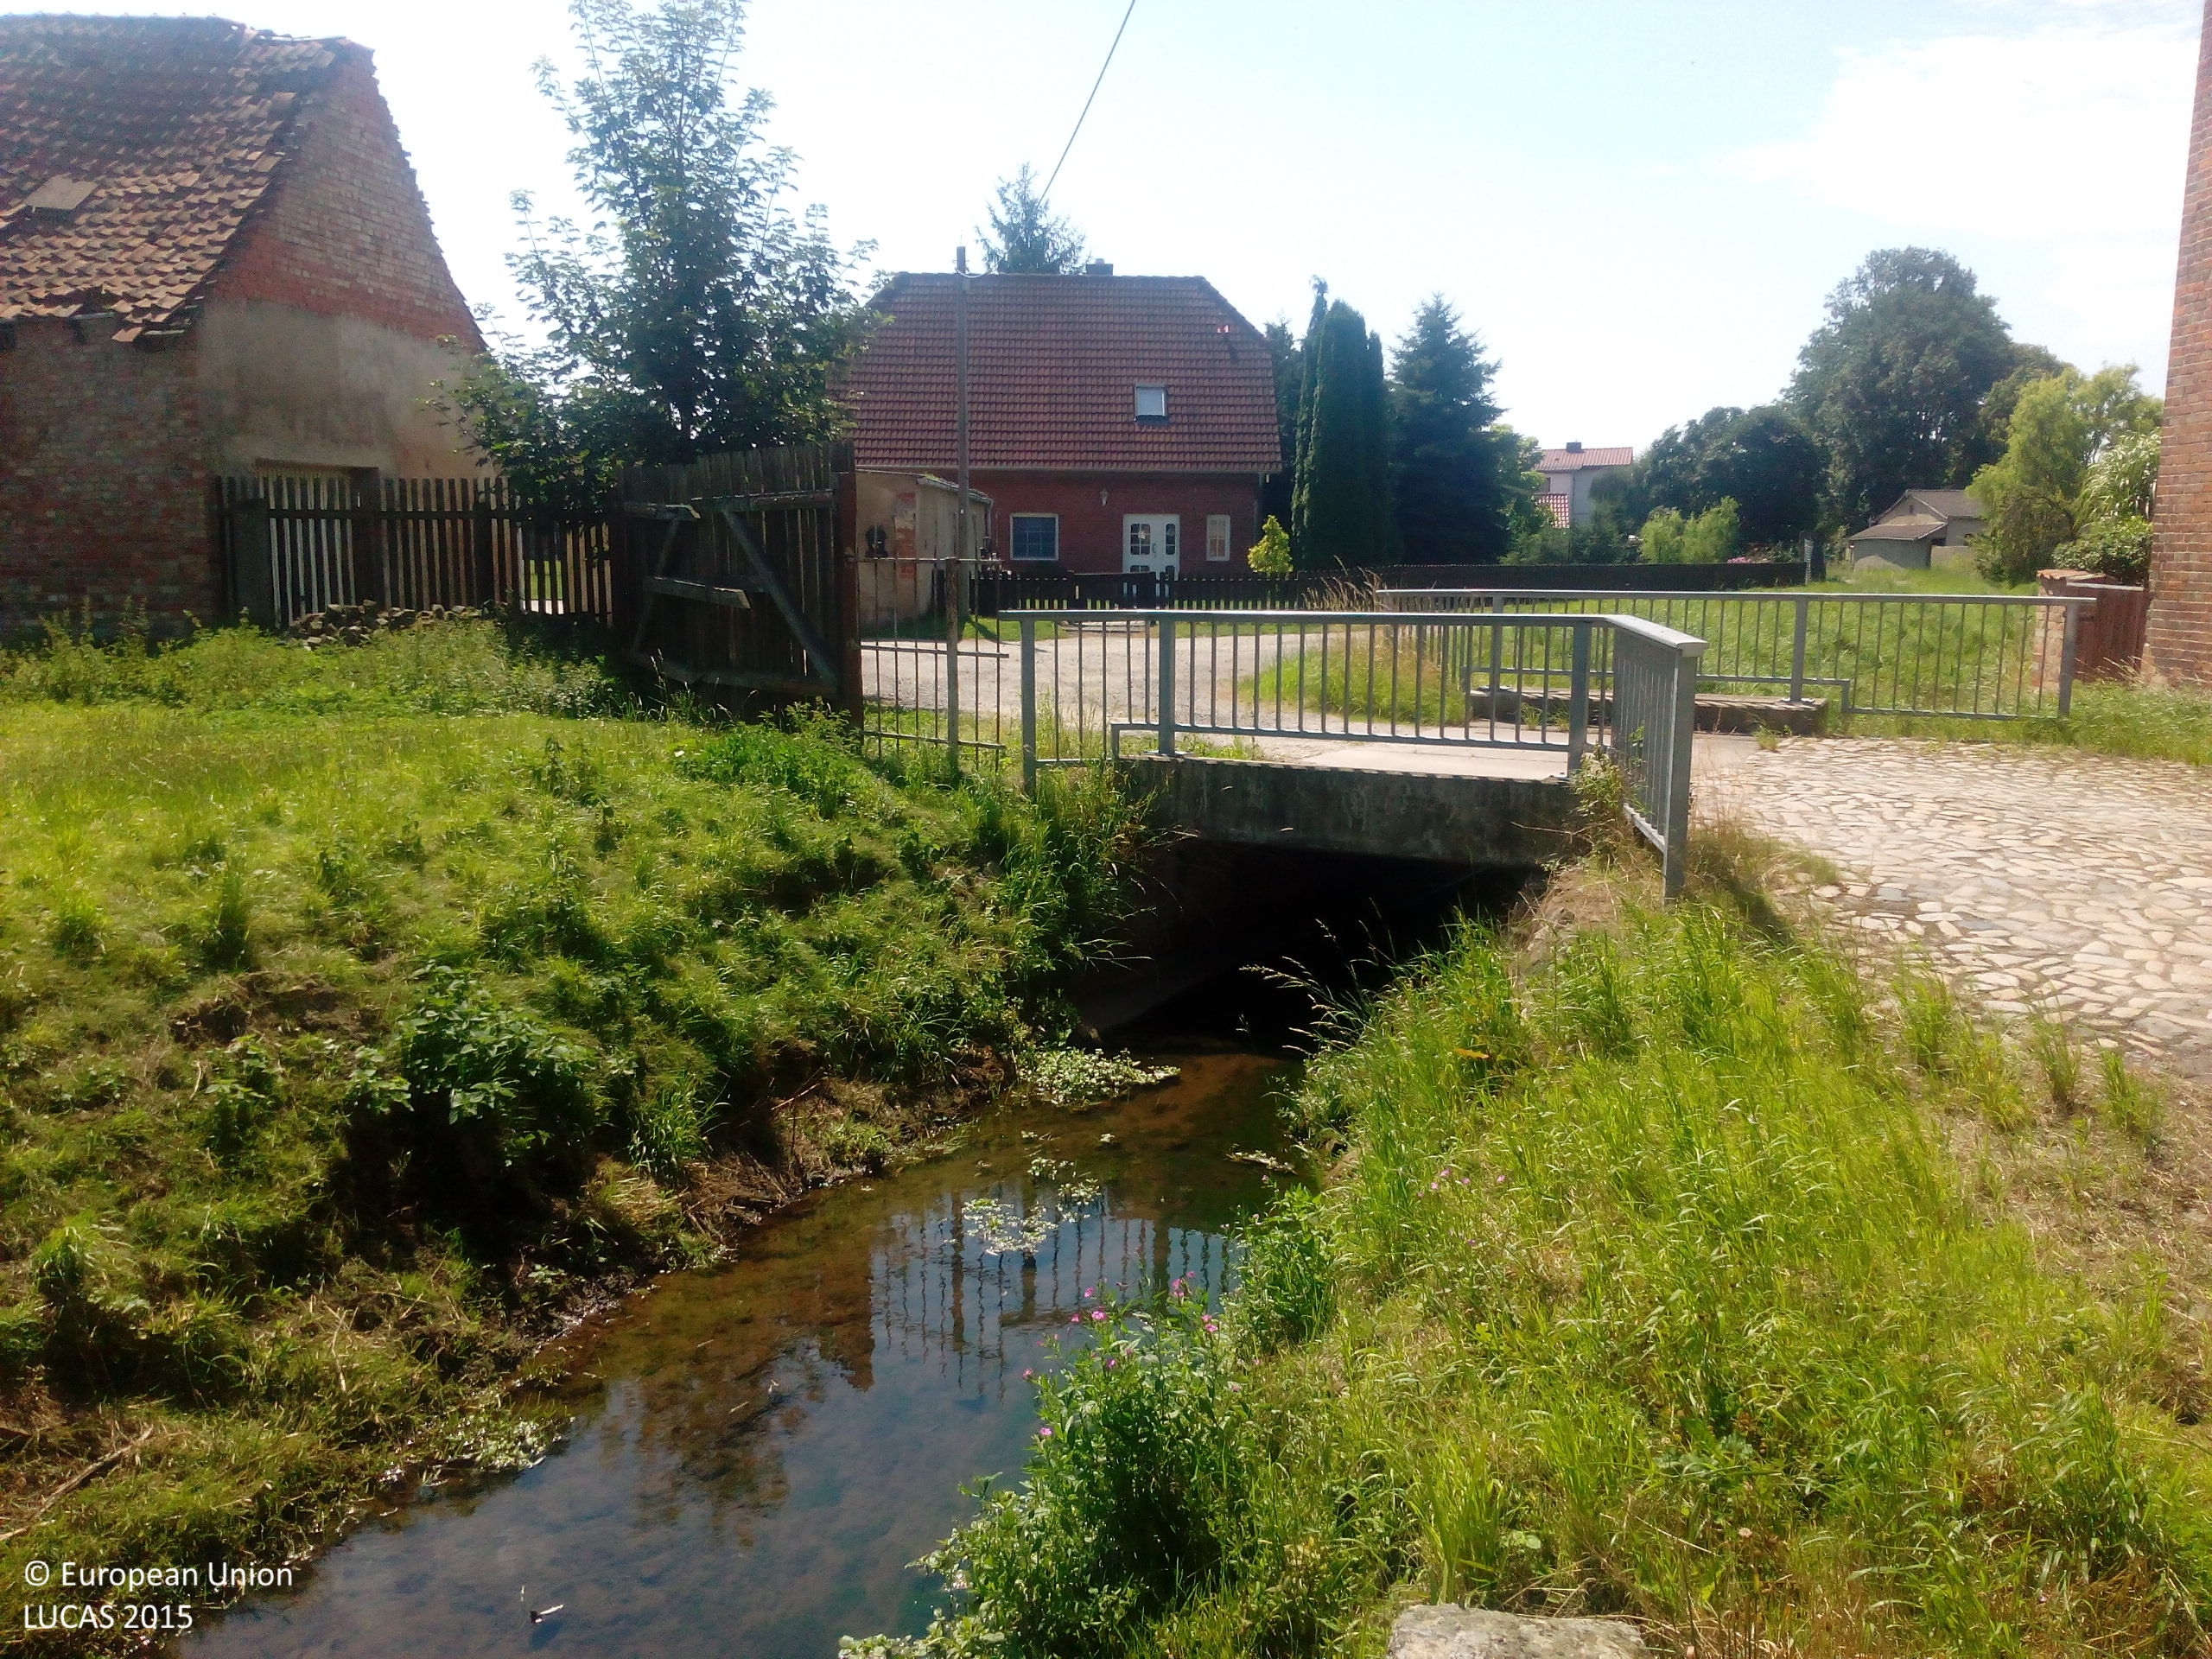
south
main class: Grassland
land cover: Grassland with sparse tree/shrub cover
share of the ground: > 75 %
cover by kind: herbaceous plants 95 %, broadleaved forest trees 5 %
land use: Residential
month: August
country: DE
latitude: 52.0845
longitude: 11.1233
